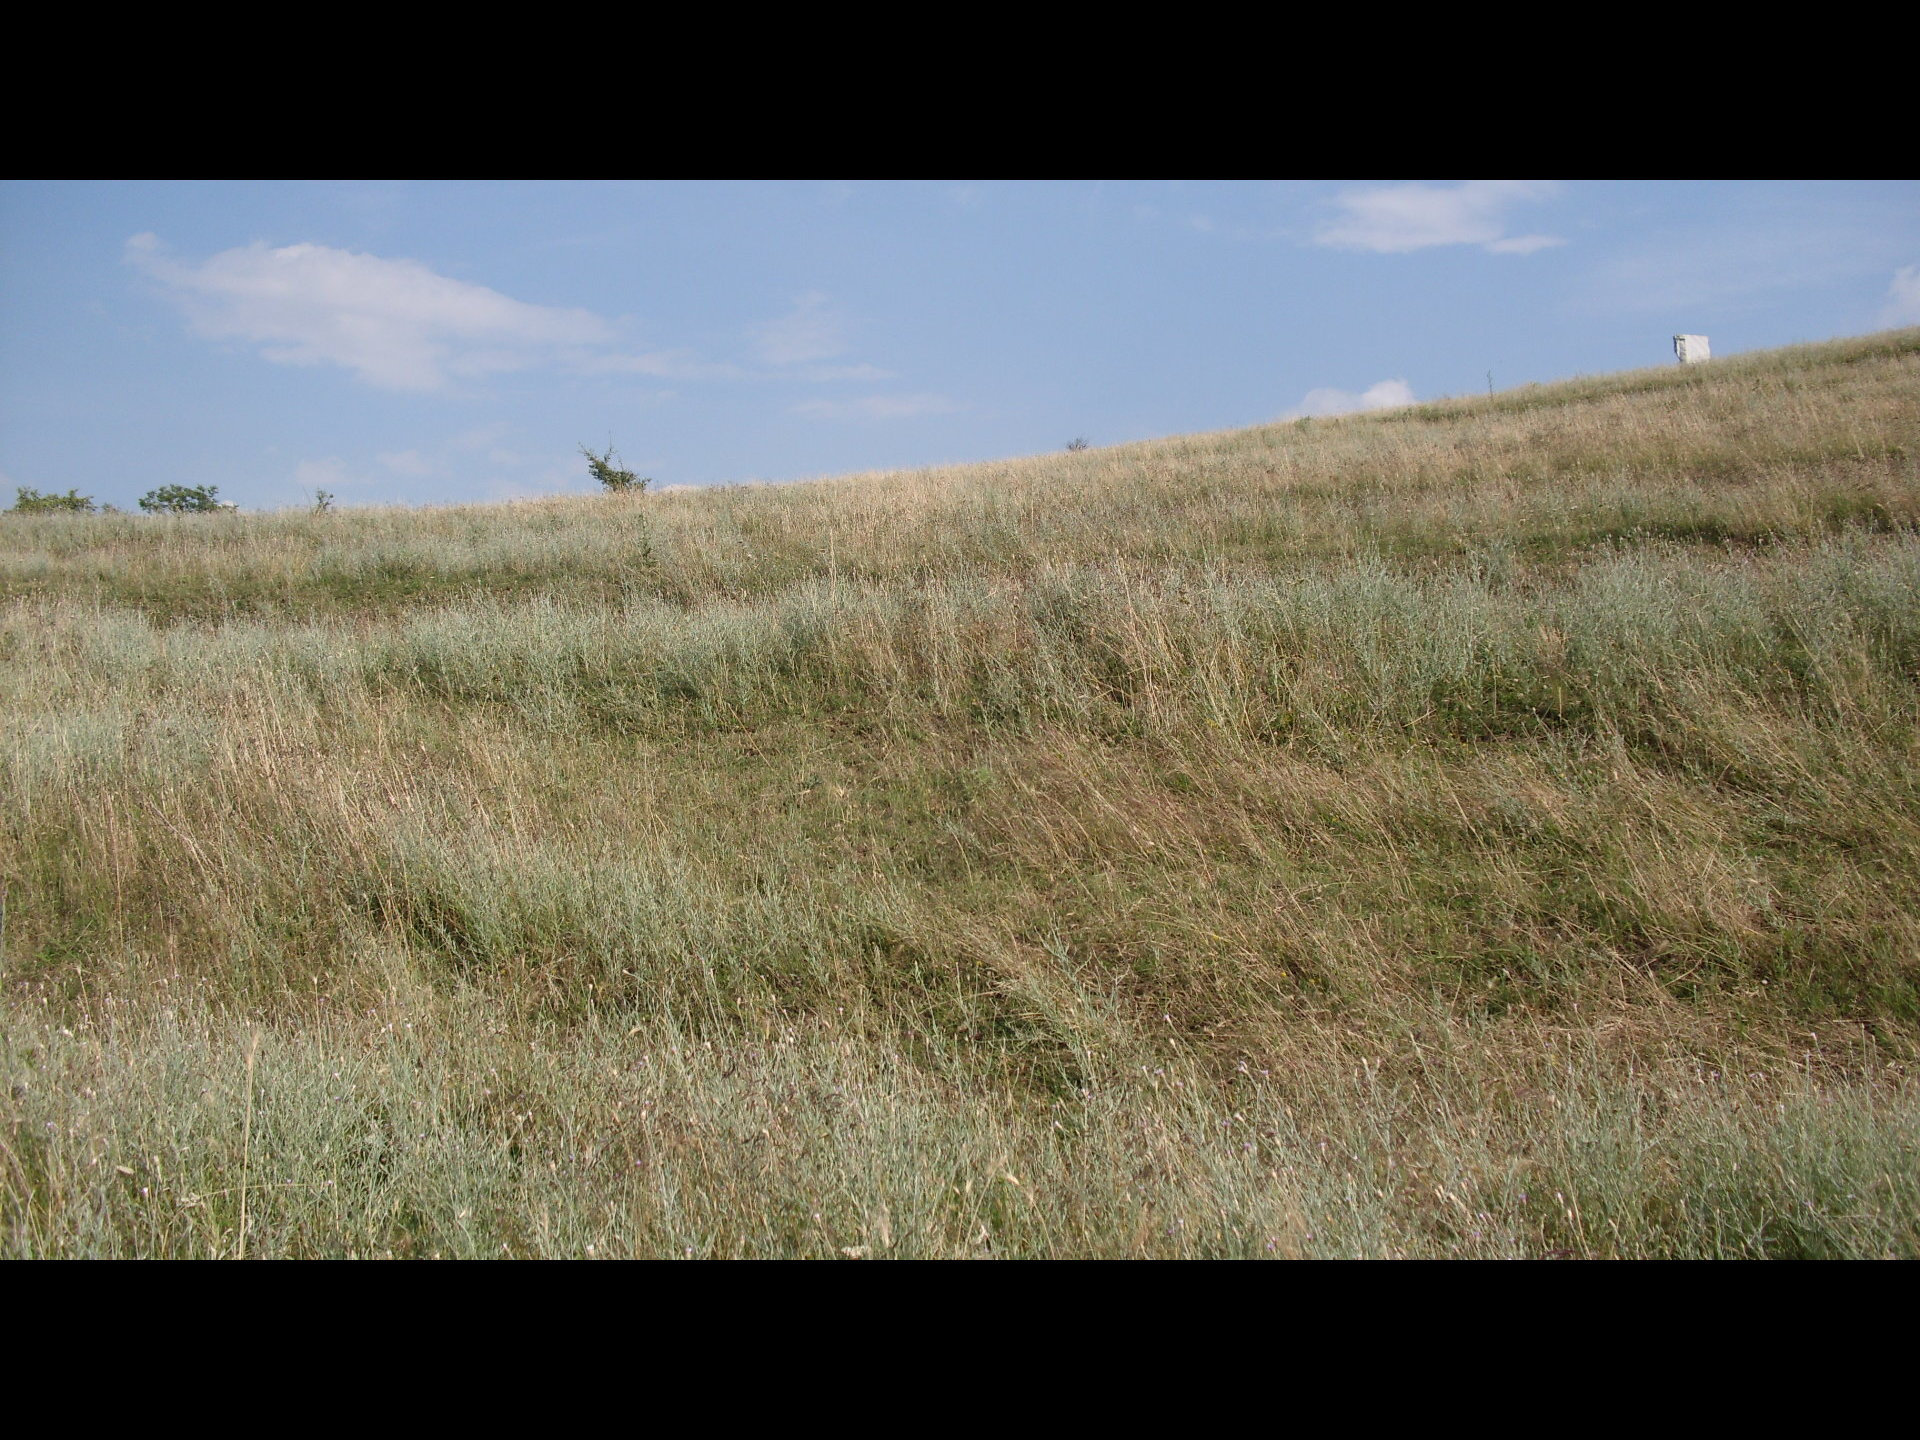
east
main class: Grassland
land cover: Grassland without tree/shrub cover
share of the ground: > 75 %
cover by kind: herbaceous plants 100 %
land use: Agriculture (excluding fallow land and kitchen gardens)
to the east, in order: Grassland without tree/shrub cover; Single bushes/trees; Grassland without tree/shrub cover
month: June
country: BG
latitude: 43.6887
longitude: 23.4567
